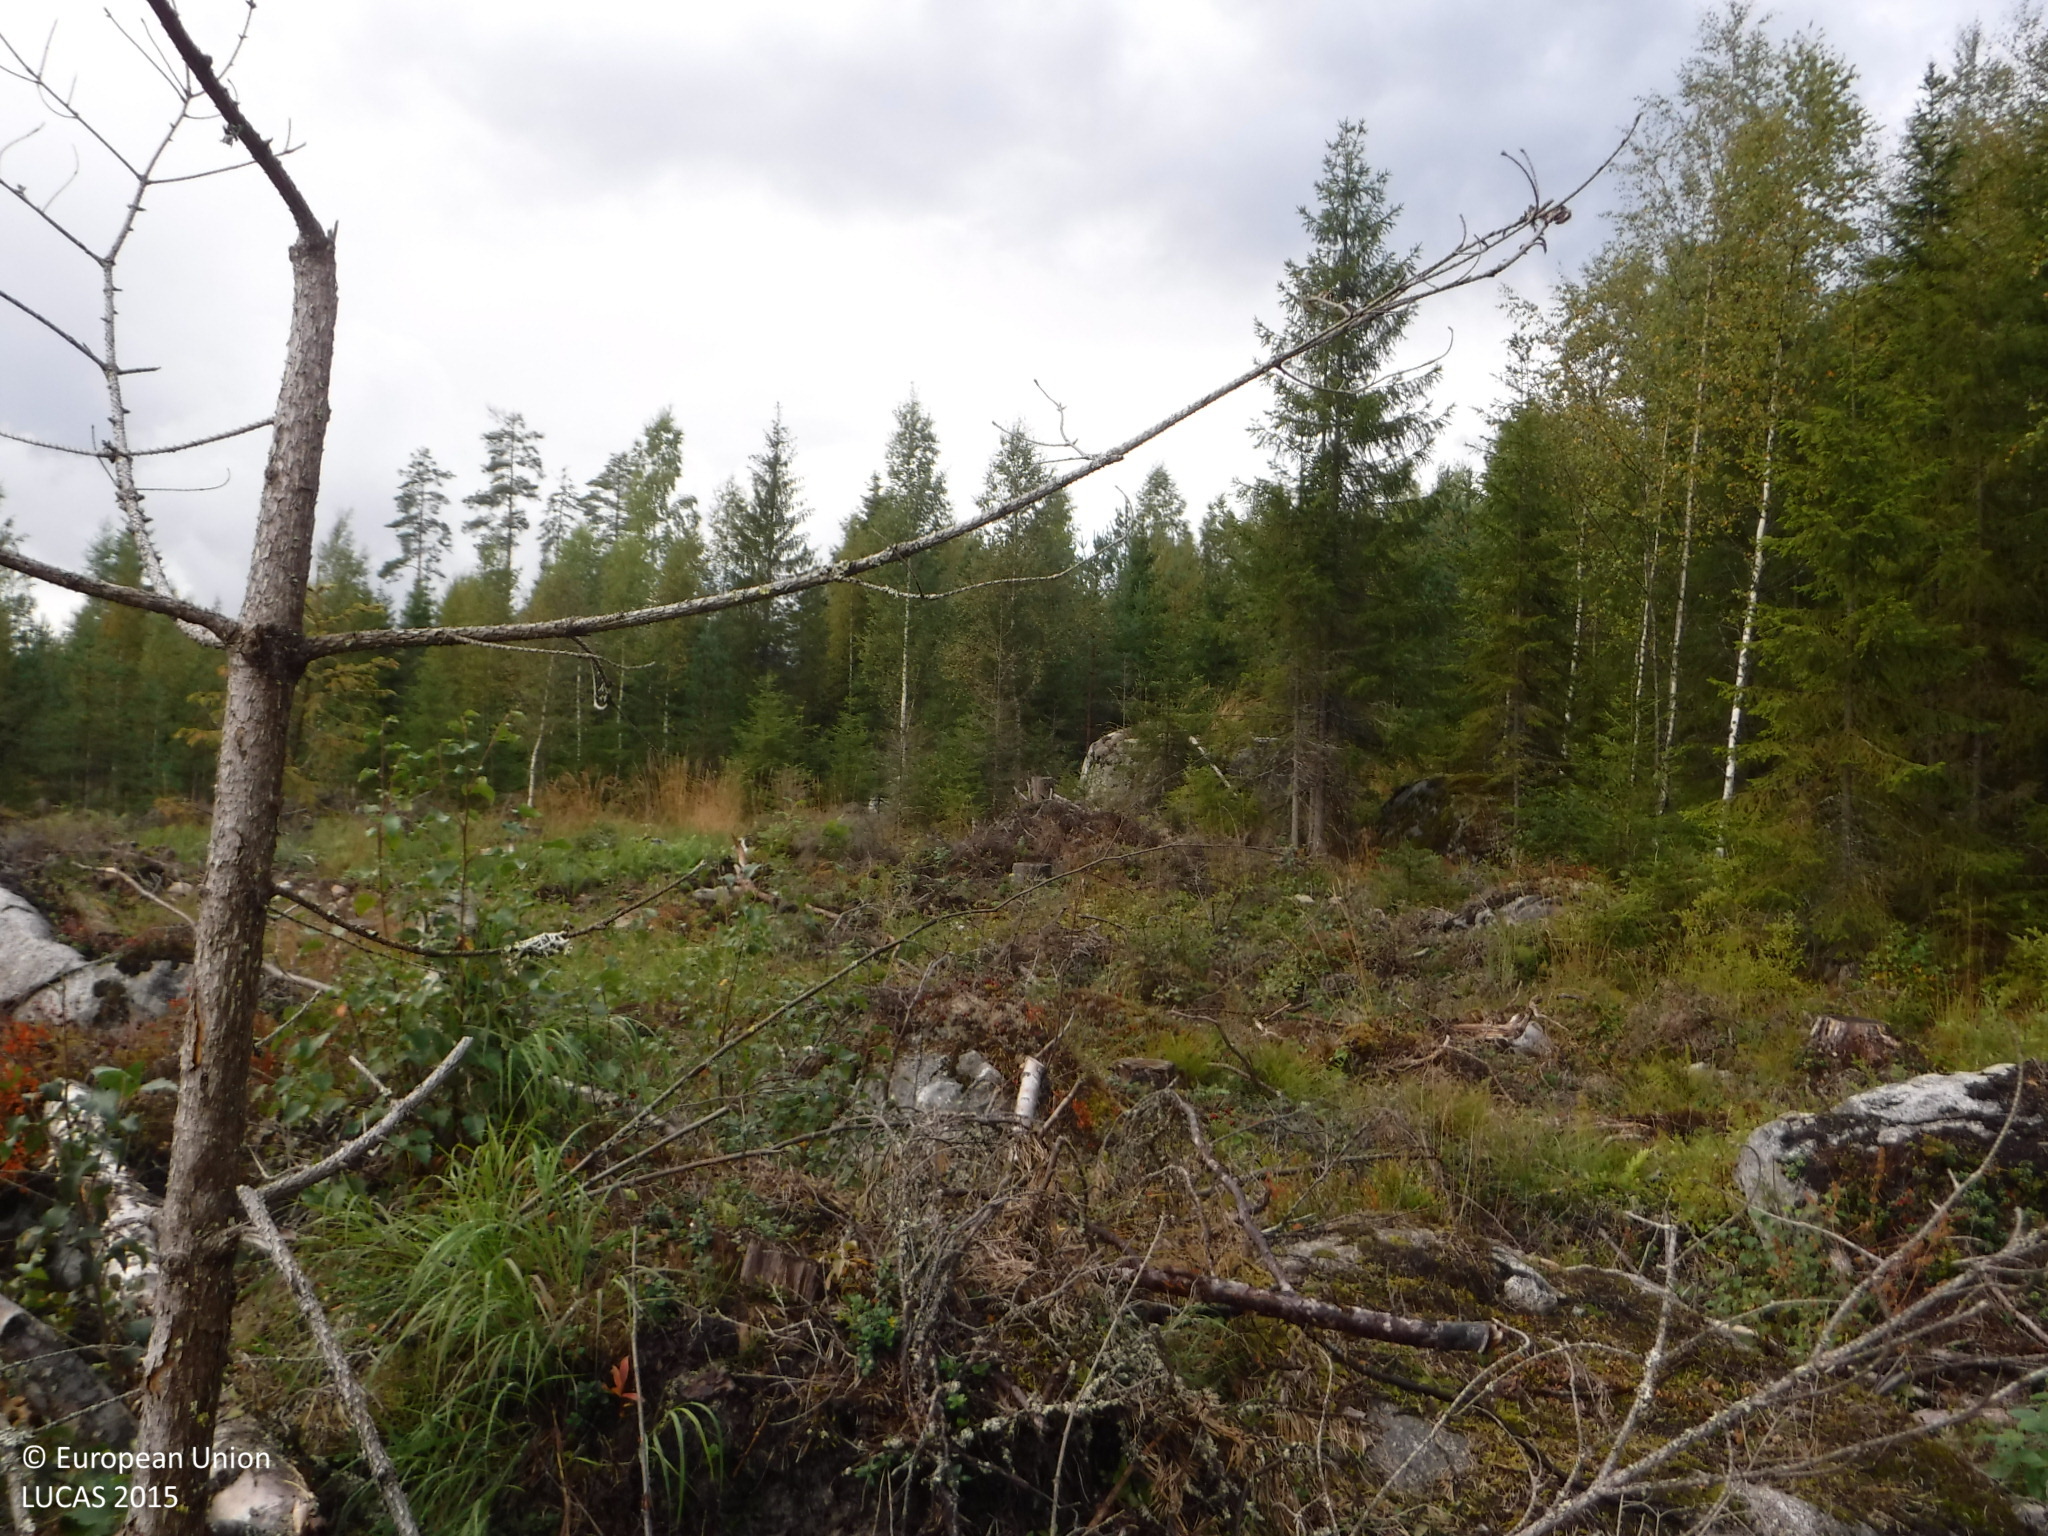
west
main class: Shrubland
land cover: Shrubland with sparse tree cover
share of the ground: 25 - 50 %
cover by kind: herbaceous plants 50 %, shrubs 30 %, unconsolidated bare surface 10 %, broadleaved forest trees 5 %, lichens and mosses 5 %
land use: Forestry
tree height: < 5 m
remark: Clear cut
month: September
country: FI
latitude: 61.3270
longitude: 22.6405
